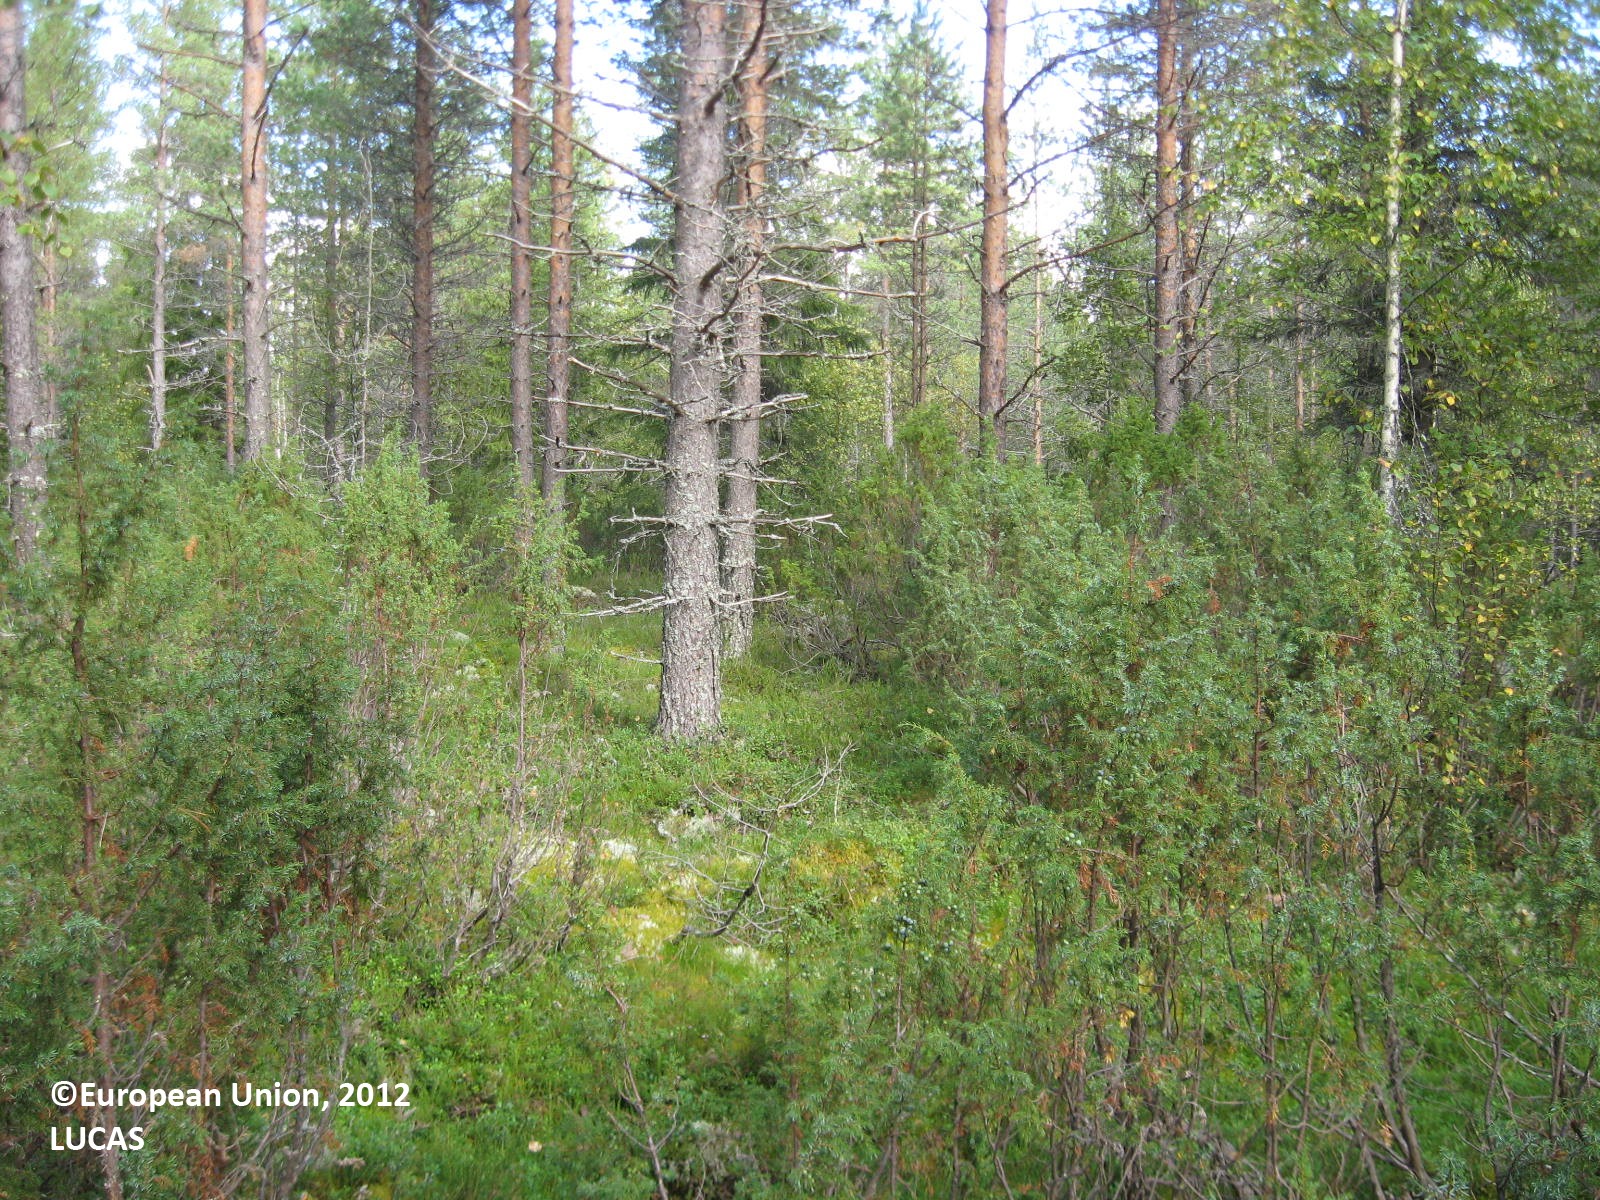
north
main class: Woodland
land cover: Pine dominated coniferous woodland
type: boreal forest
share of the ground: > 75 %
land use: Forestry
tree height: > 5 m
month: August
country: FI
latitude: 63.6925
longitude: 29.4980
